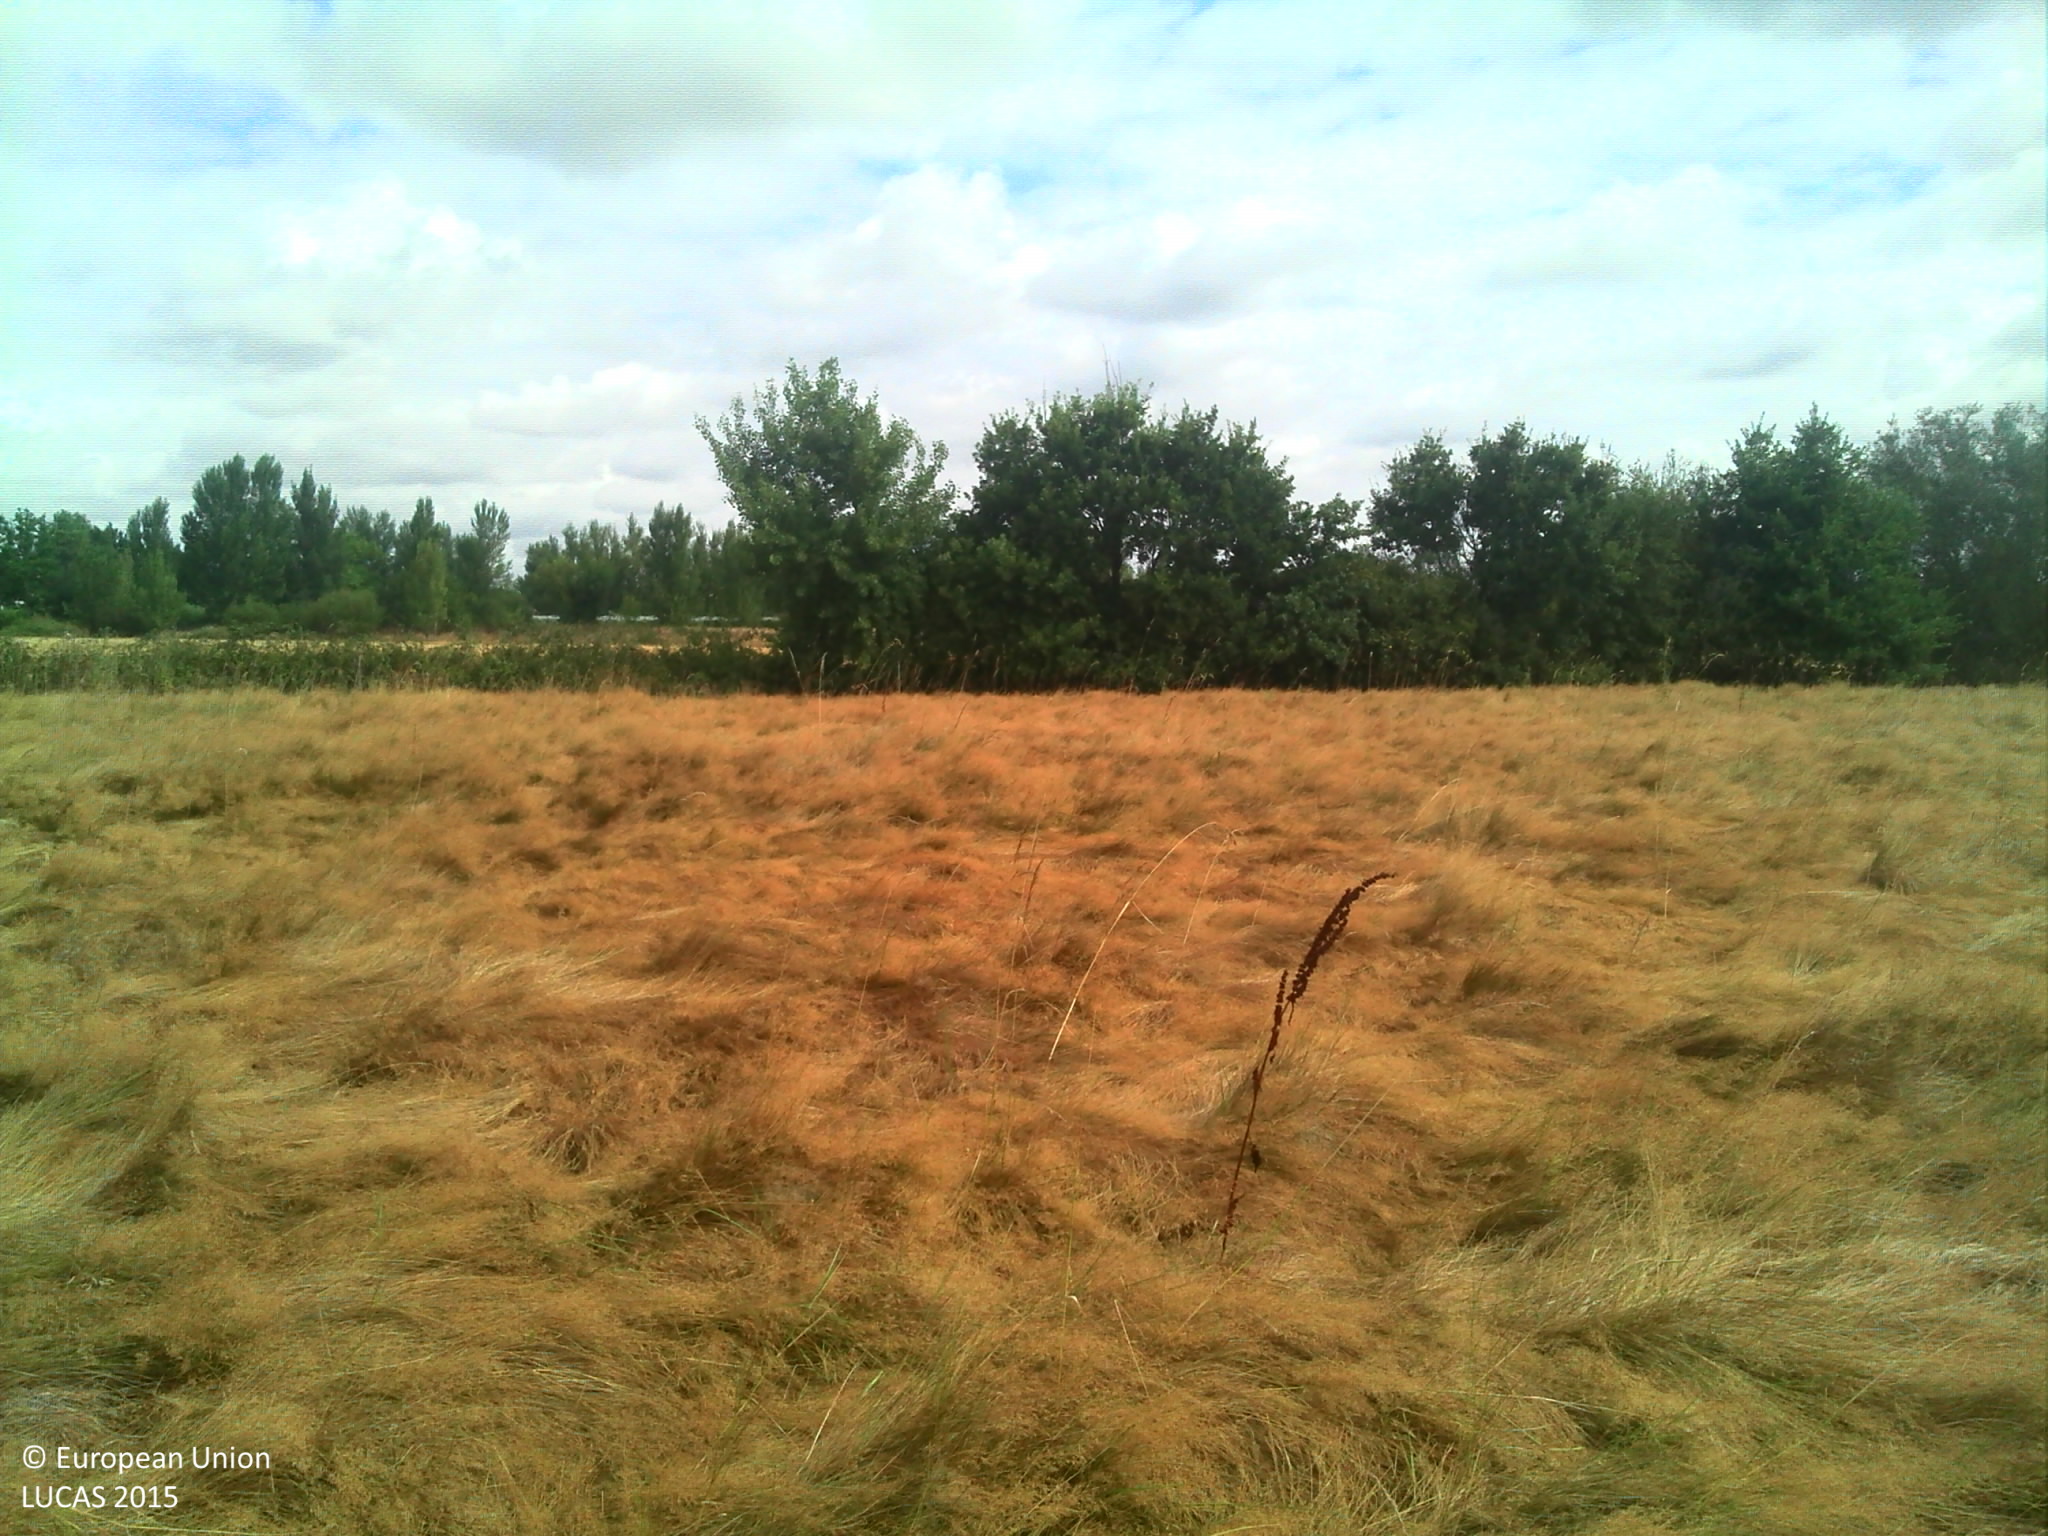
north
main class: Grassland
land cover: Grassland without tree/shrub cover
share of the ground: > 75 %
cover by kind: herbaceous plants 100 %
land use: Agriculture (excluding fallow land and kitchen gardens)
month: July
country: FR
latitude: 43.2418
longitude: 1.0992
